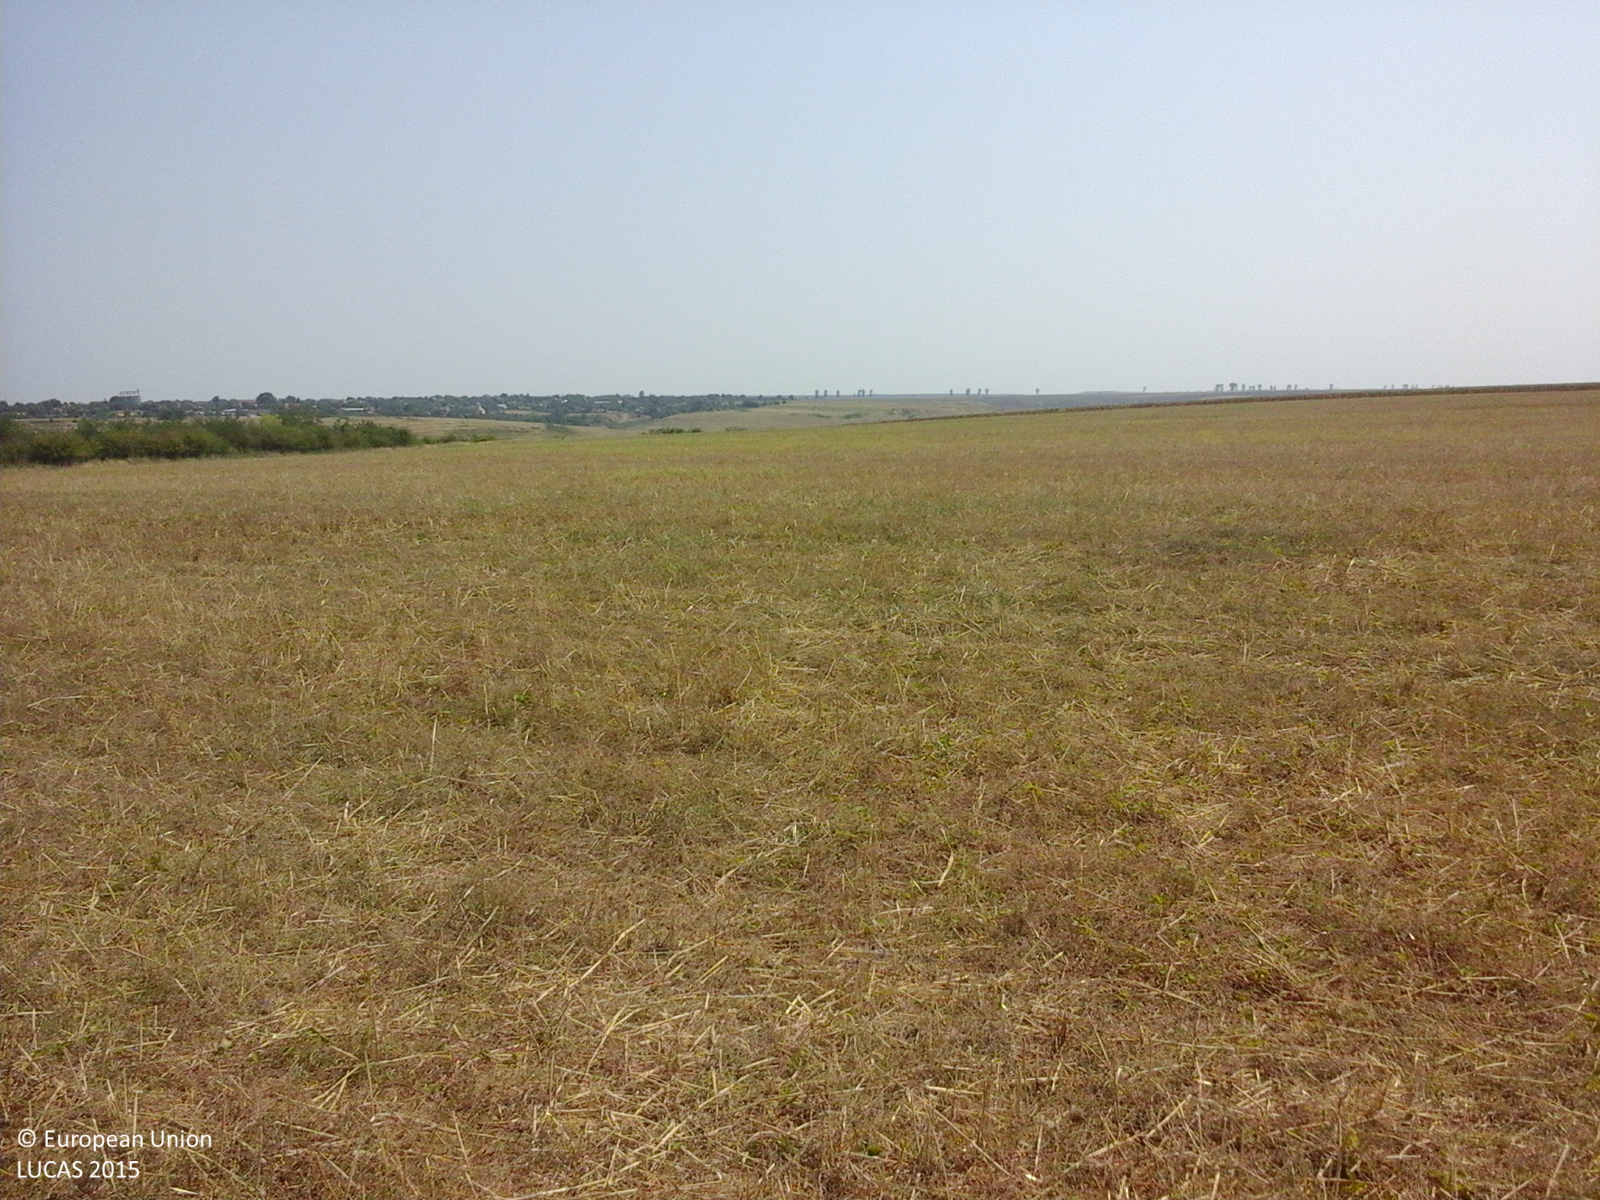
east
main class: Cropland
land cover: Common wheat
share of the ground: 50 - 75 %
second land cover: Spontaneously vegetated surfaces
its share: 50 - 75 %
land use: Agriculture (excluding fallow land and kitchen gardens)
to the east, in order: Common wheat; Spontaneously vegetated surfaces
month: August
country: RO
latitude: 44.2264
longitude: 23.2542
